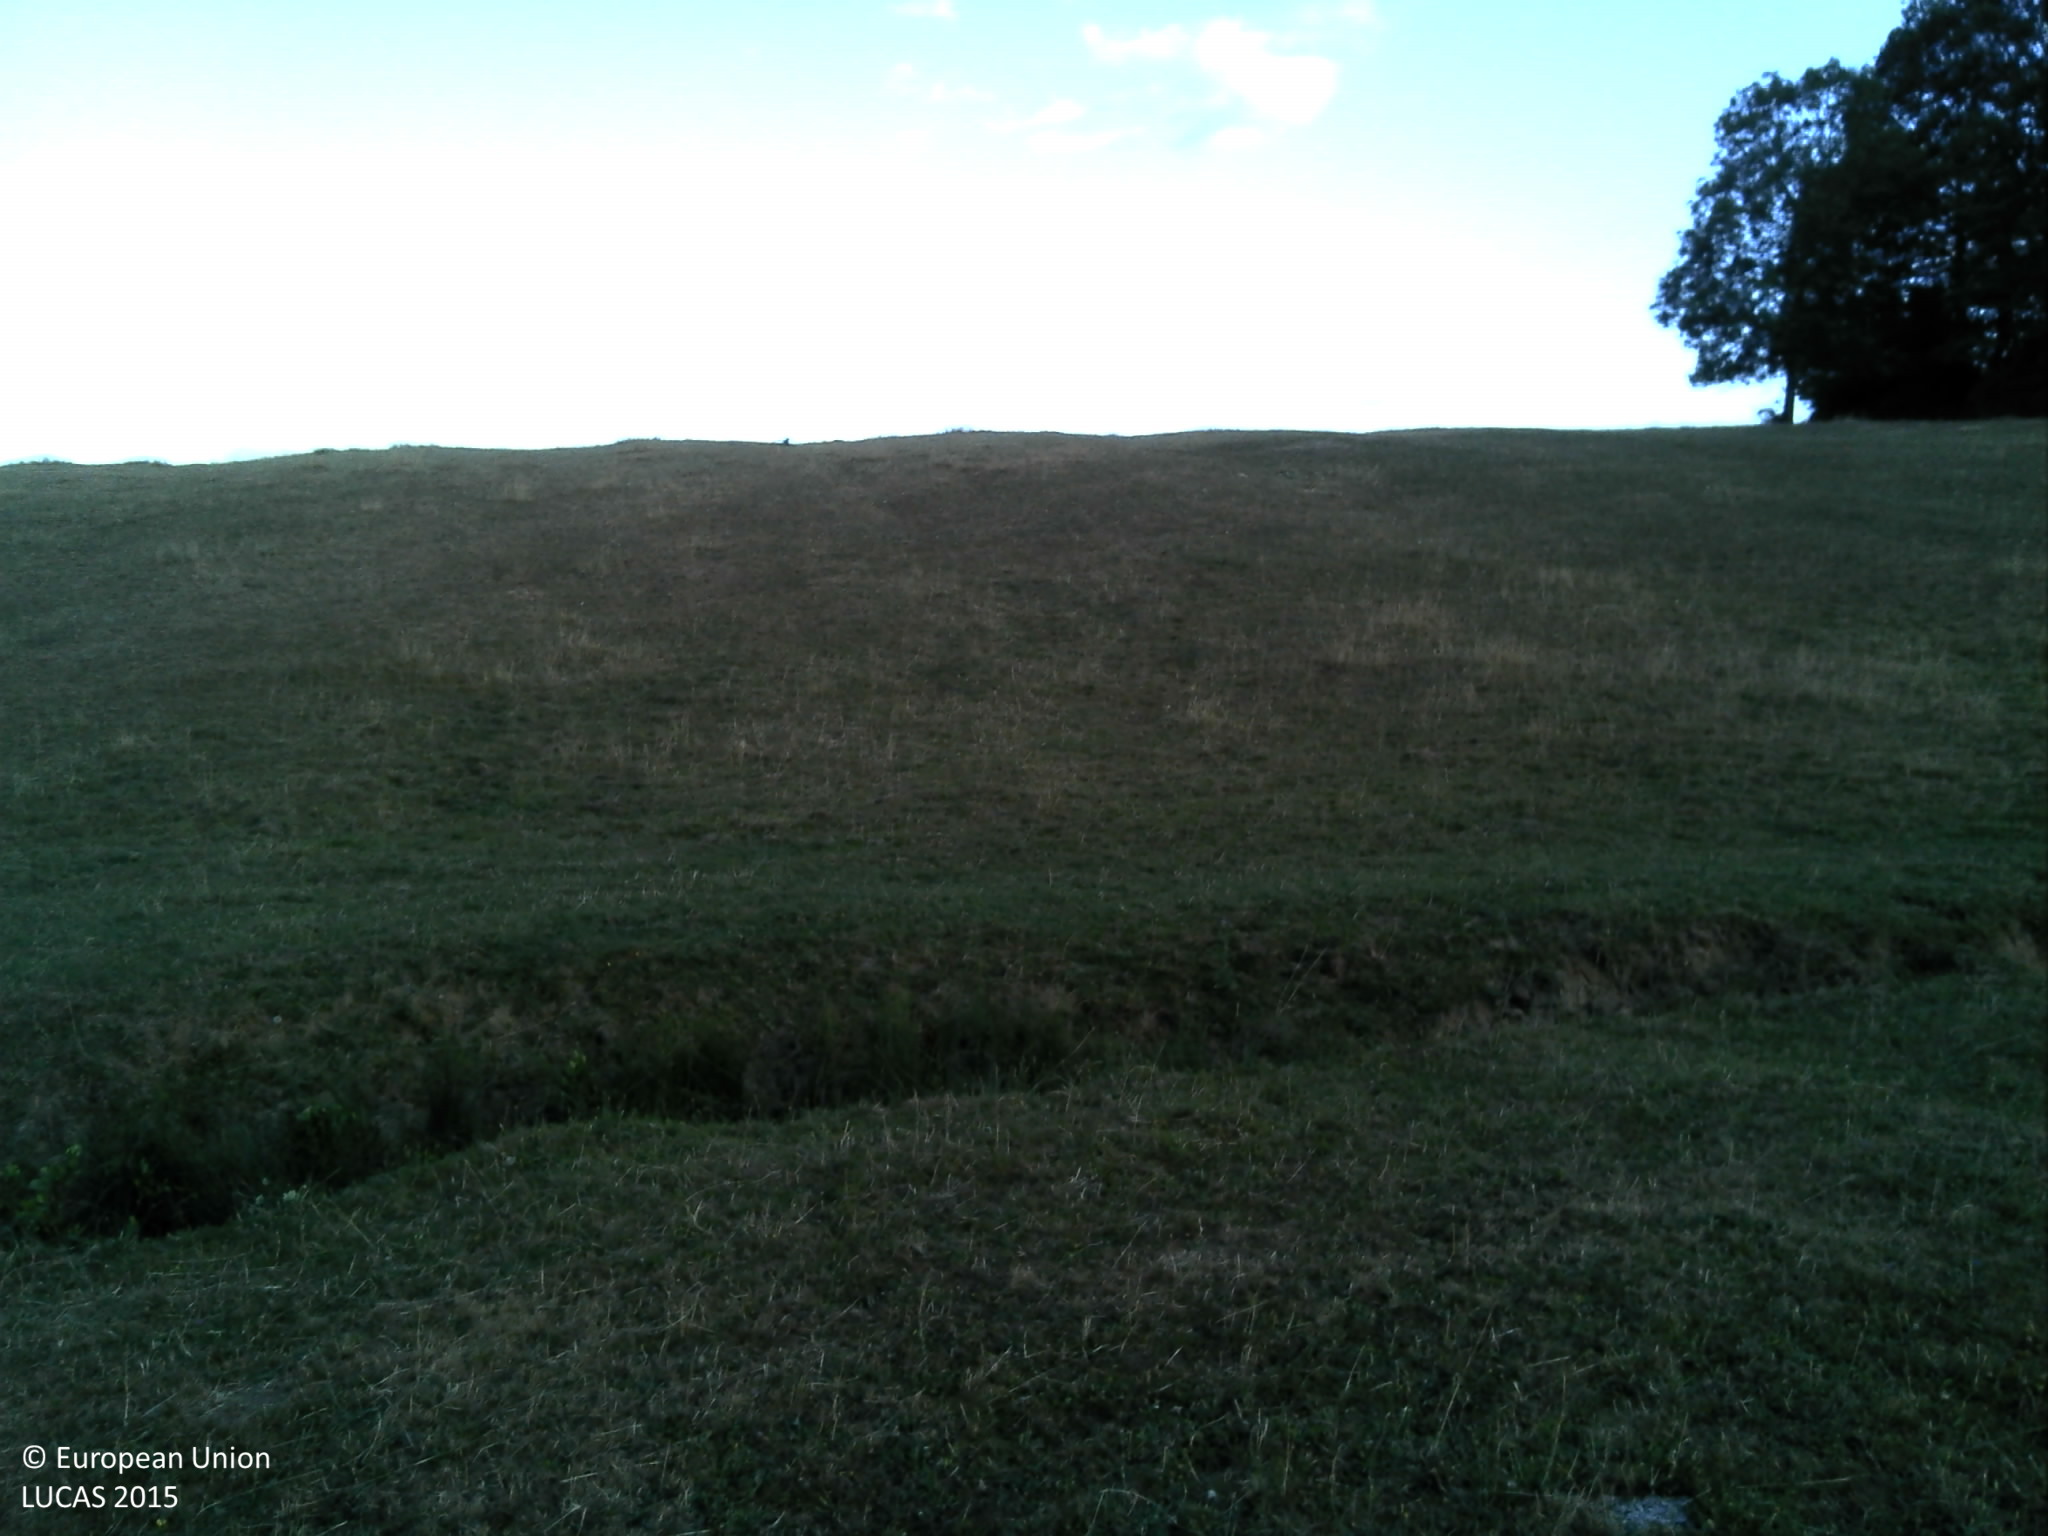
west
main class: Grassland
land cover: Grassland with sparse tree/shrub cover
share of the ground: > 75 %
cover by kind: herbaceous plants 95 %, broadleaved forest trees 5 %
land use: Agriculture (excluding fallow land and kitchen gardens)
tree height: > 5 m
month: July
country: FR
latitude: 48.3017
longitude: 6.1852
